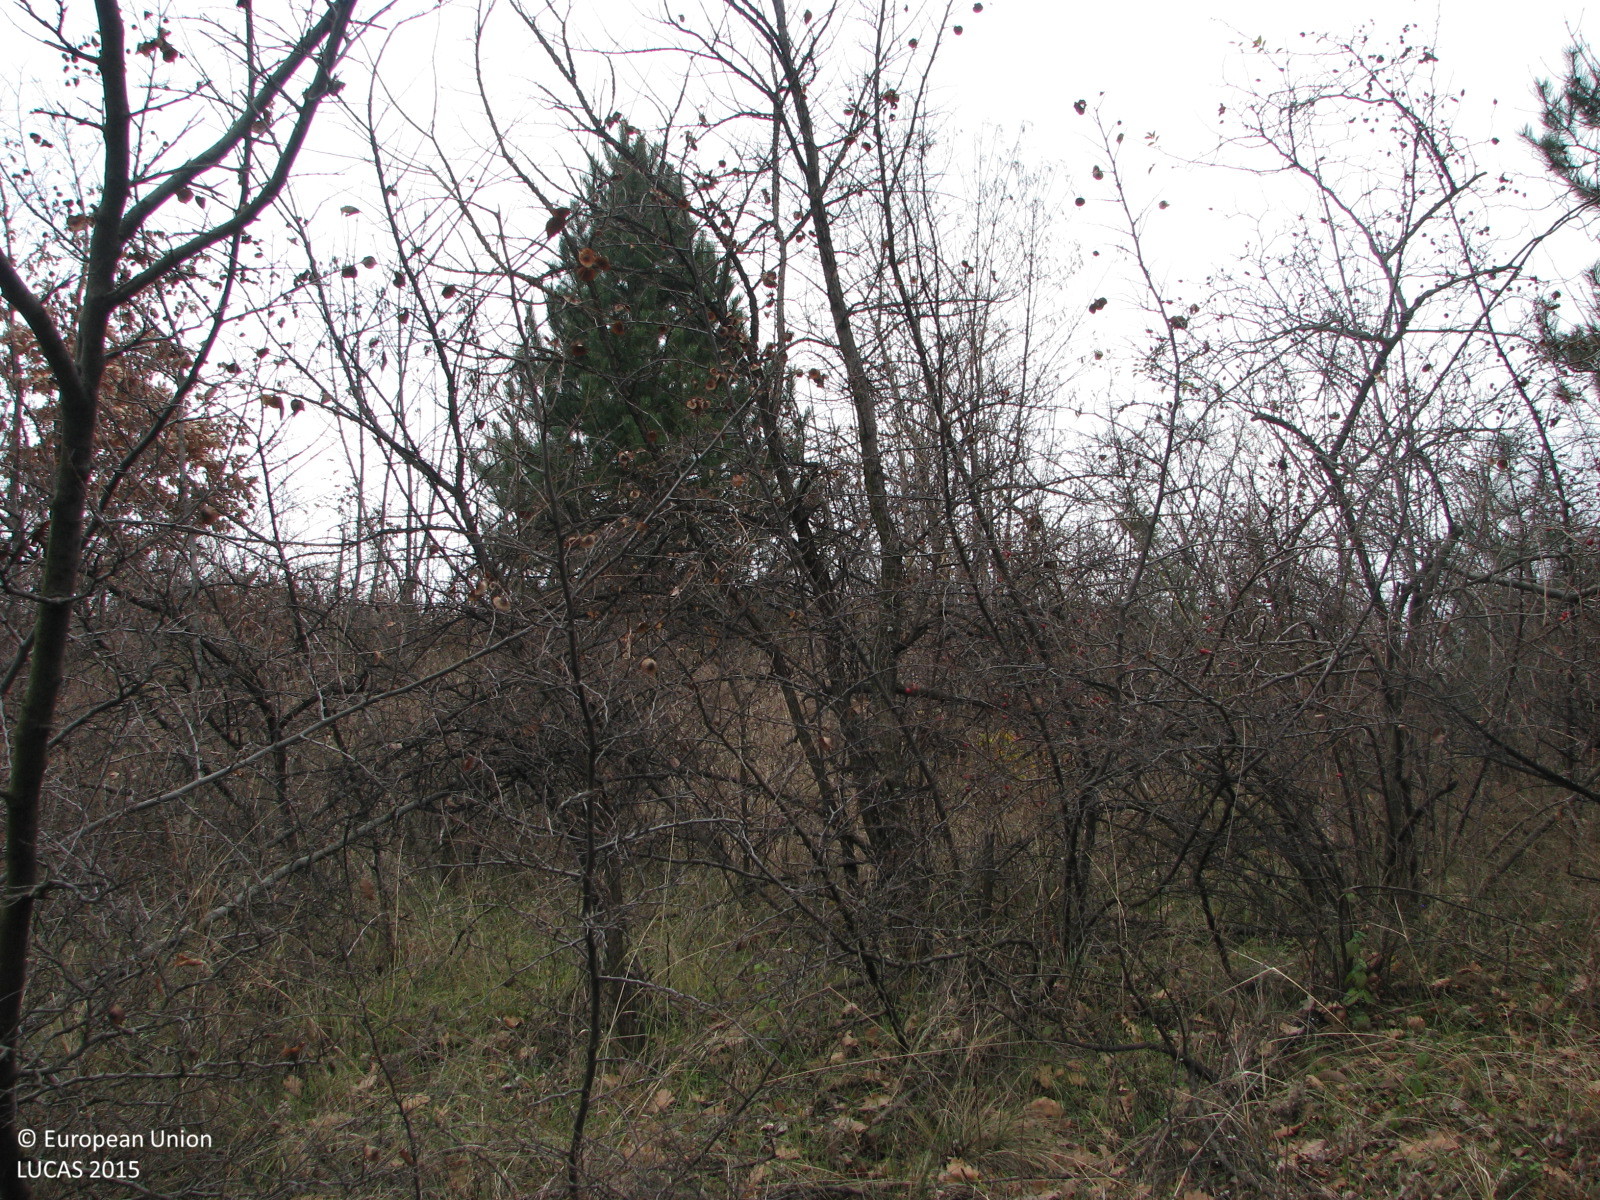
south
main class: Woodland
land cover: Other mixed woodland
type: hemiboreal forest and nemoral coniferous forest and mixed broadleaved-coniferous forest
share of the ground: > 75 %
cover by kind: coniferous forest trees 50 %, broadleaved forest trees 35 %, shrubs 5 %, herbaceous plants 5 %, unconsolidated bare surface 5 %
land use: Forestry
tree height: > 5 m
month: December
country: BG
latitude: 42.2241
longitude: 24.0088
